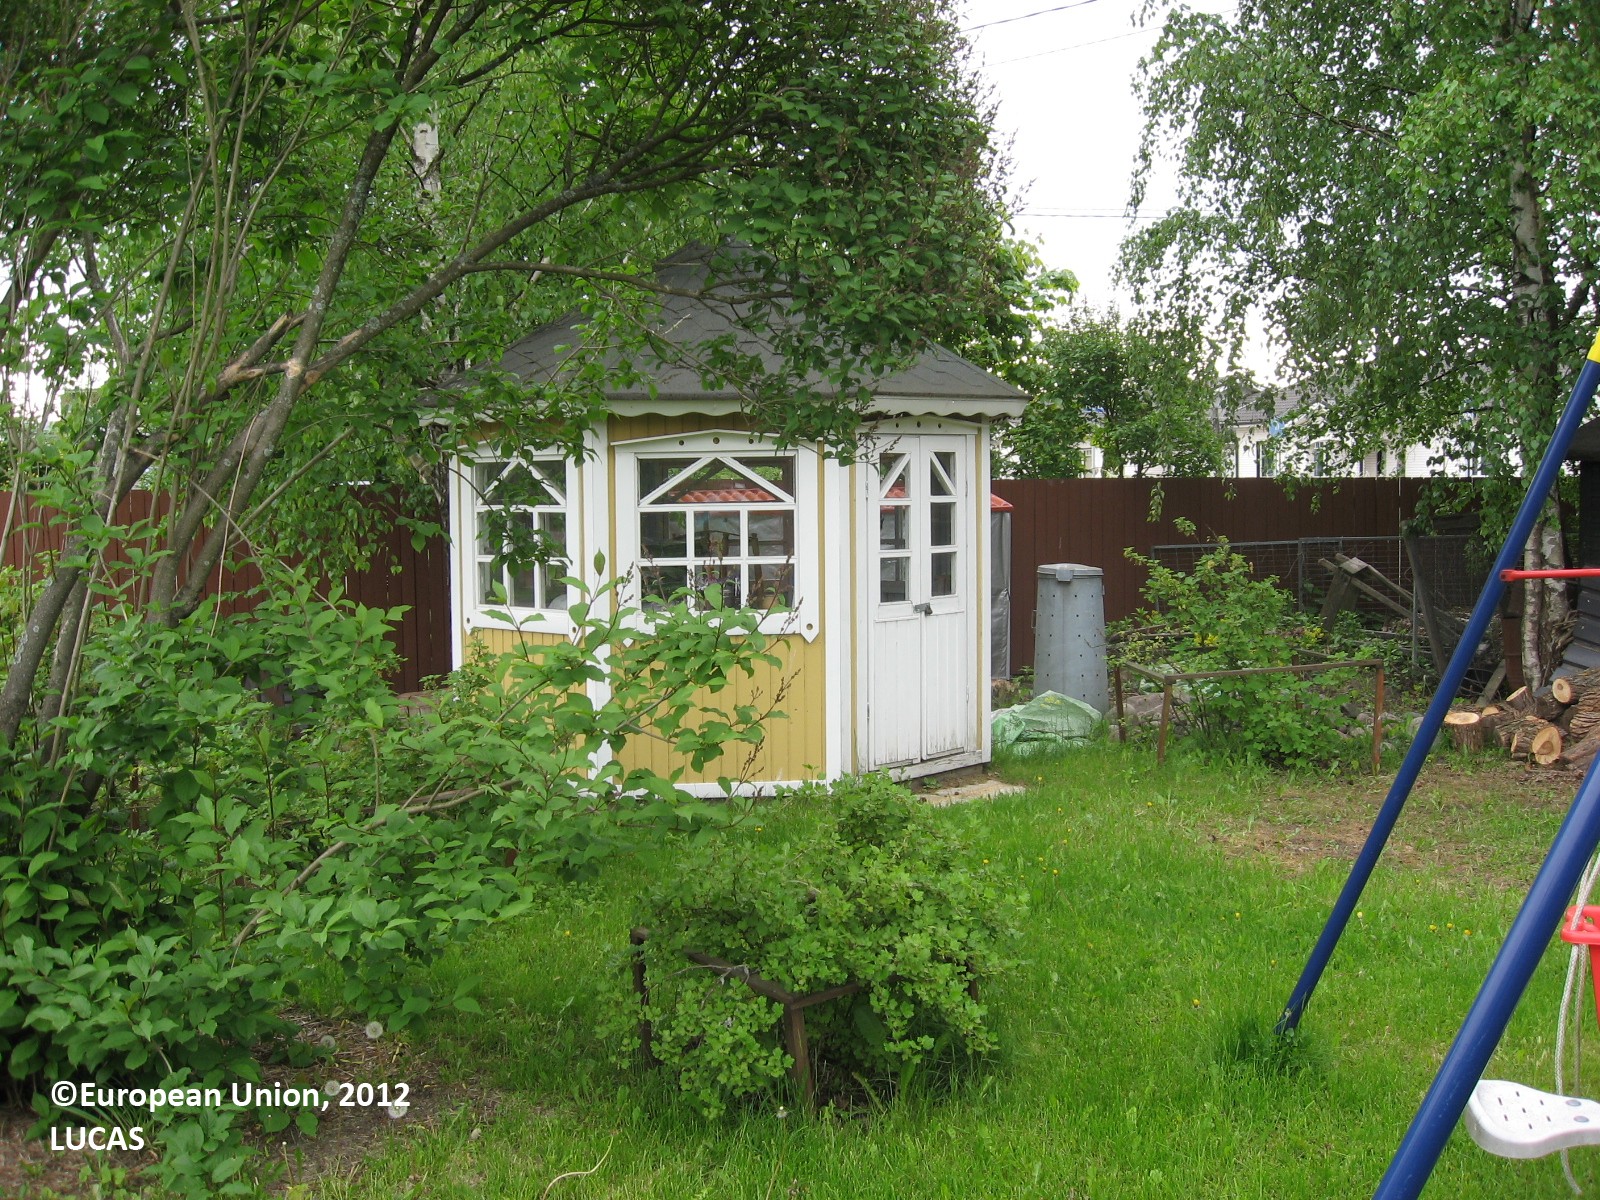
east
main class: Grassland
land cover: Grassland with sparse tree/shrub cover
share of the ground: > 75 %
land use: Residential
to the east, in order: Grassland with sparse tree/shrub cover; Artificial constructions in urban areas
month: June
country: FI
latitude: 60.2900
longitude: 25.0061
